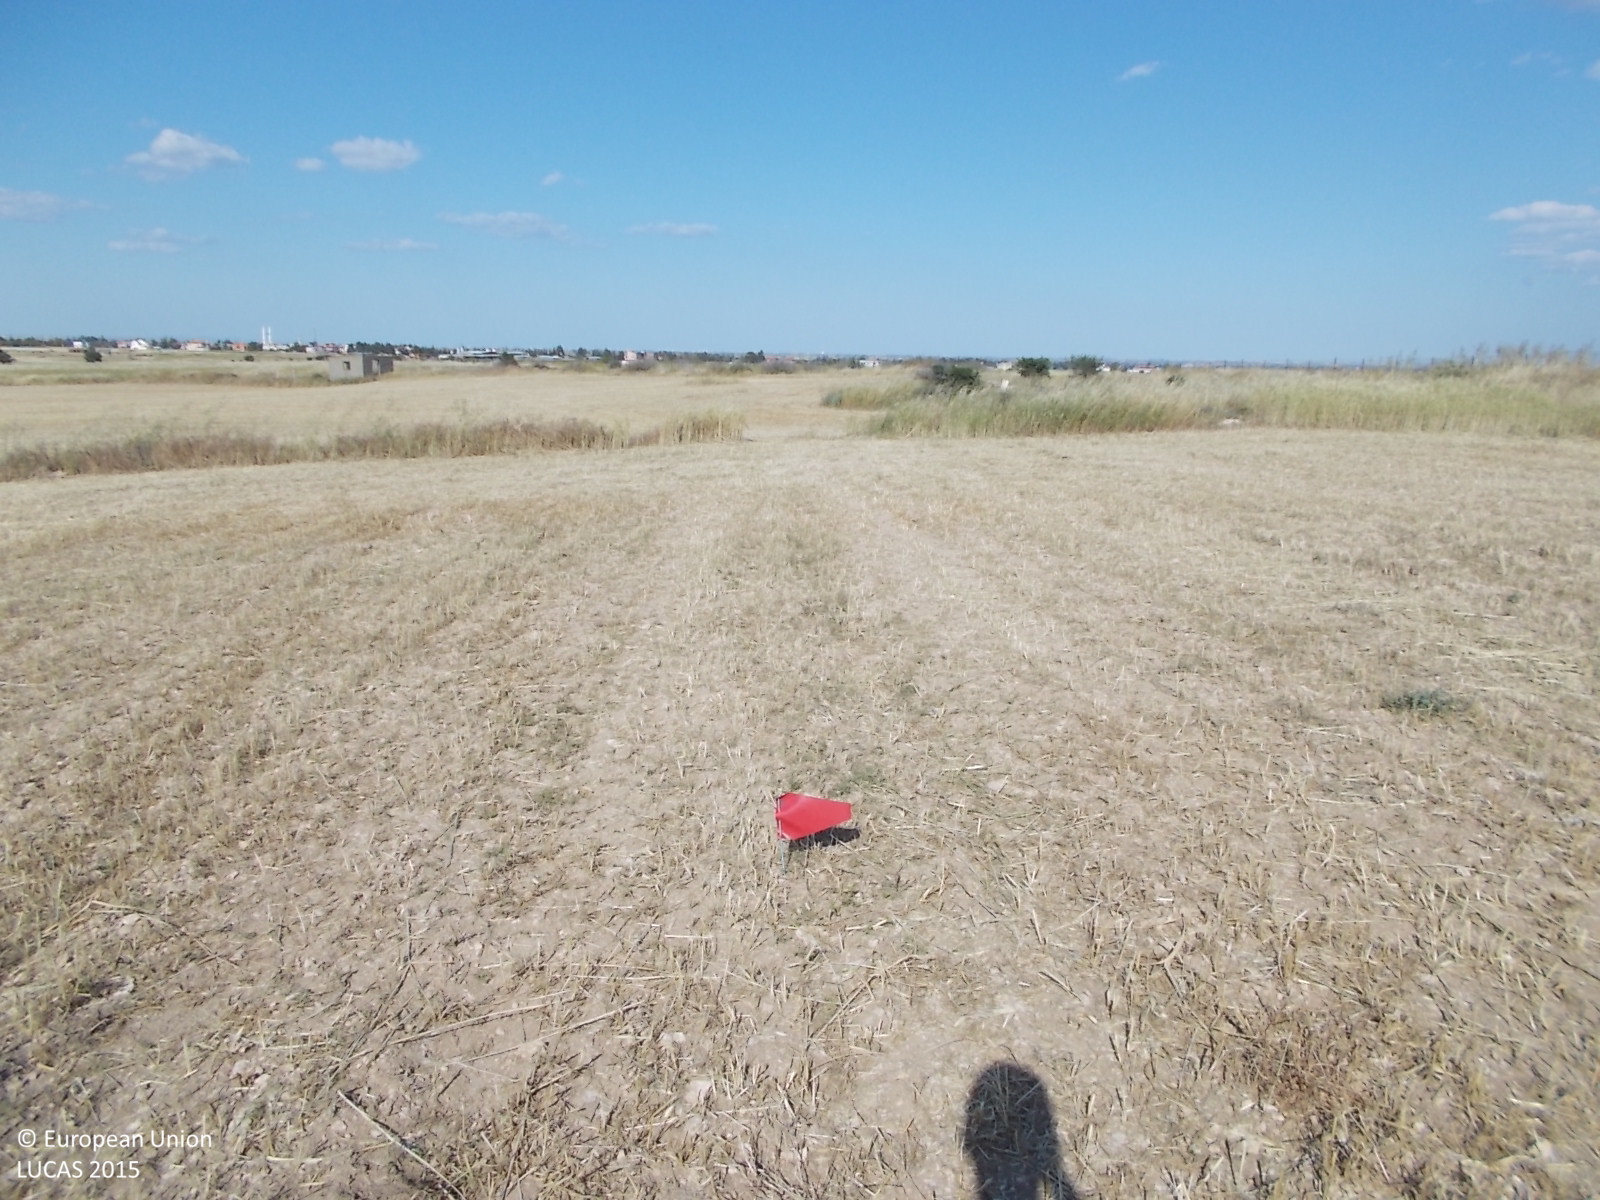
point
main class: Cropland
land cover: Common wheat
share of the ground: < 10 %
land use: Agriculture (excluding fallow land and kitchen gardens)
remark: Harvested field
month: April
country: CY
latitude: 35.0276
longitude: 33.6911
